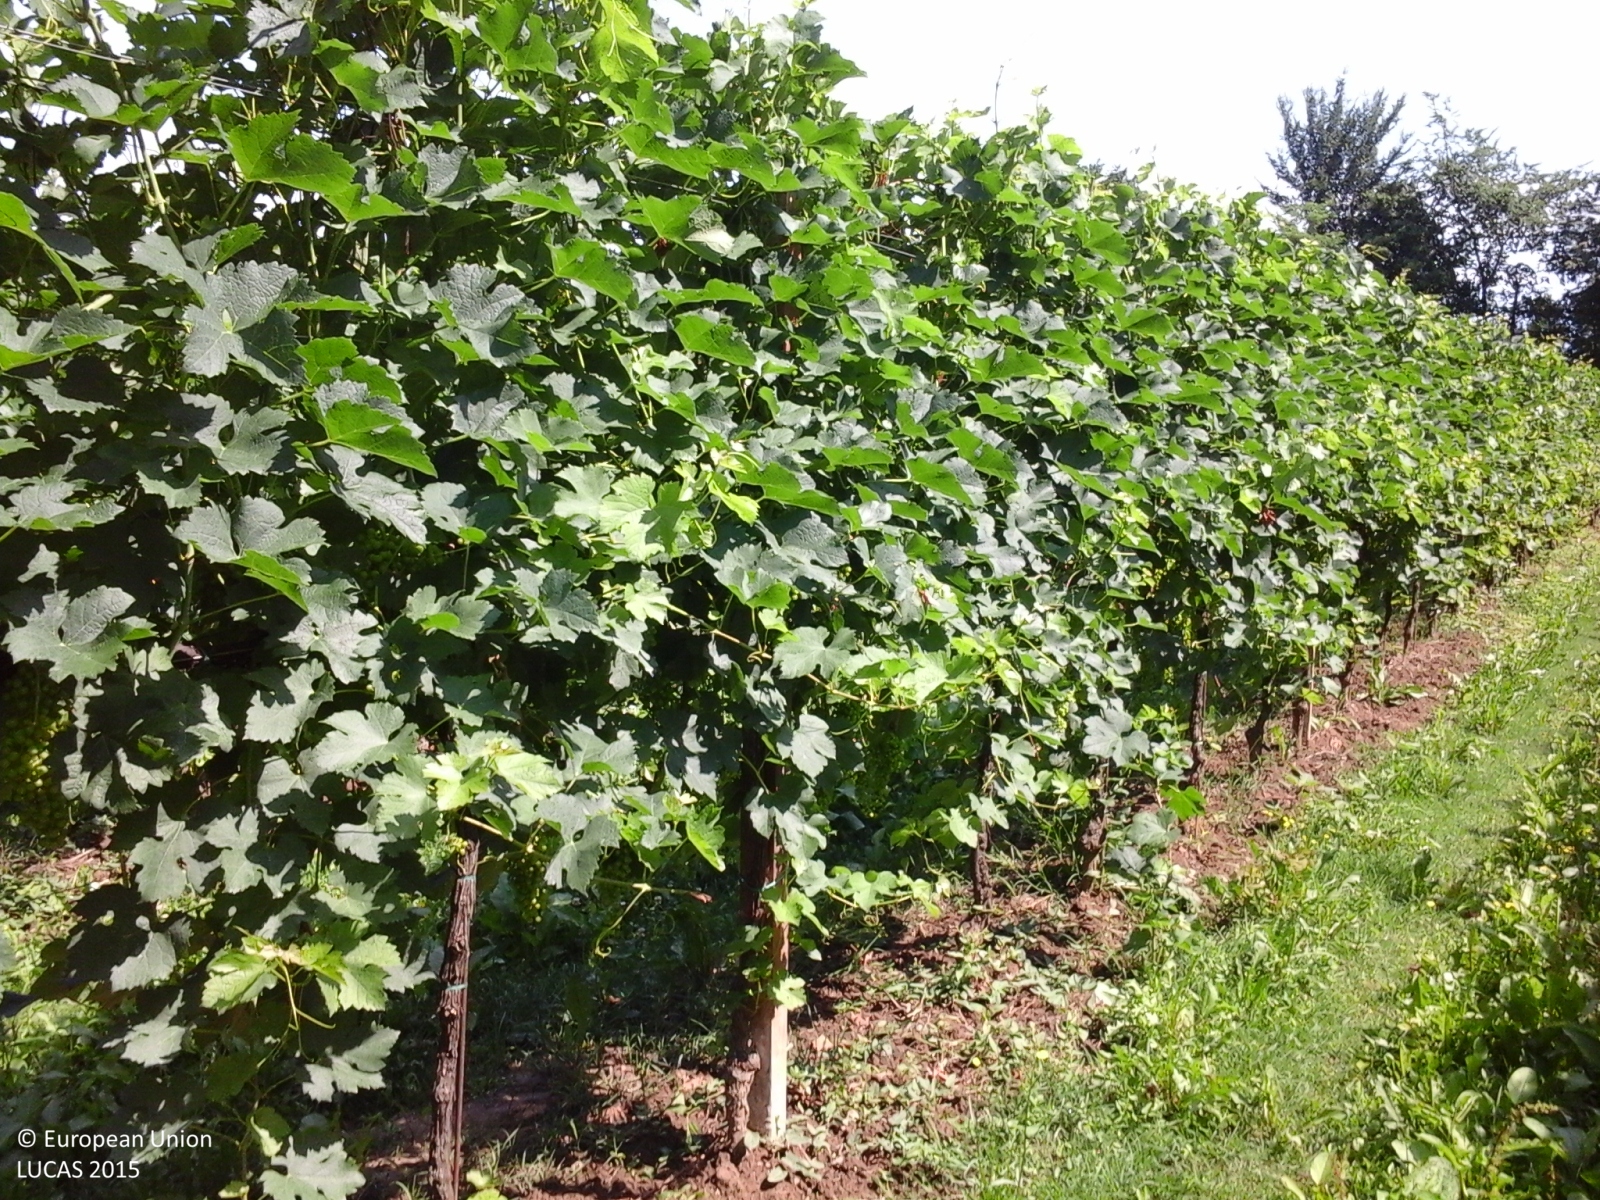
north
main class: Cropland
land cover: Vineyards
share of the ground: 25 - 50 %
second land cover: Grassland without tree/shrub cover
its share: > 75 %
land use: Agriculture (excluding fallow land and kitchen gardens)
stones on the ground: < 10 %
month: June
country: IT
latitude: 45.8928
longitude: 12.3552
